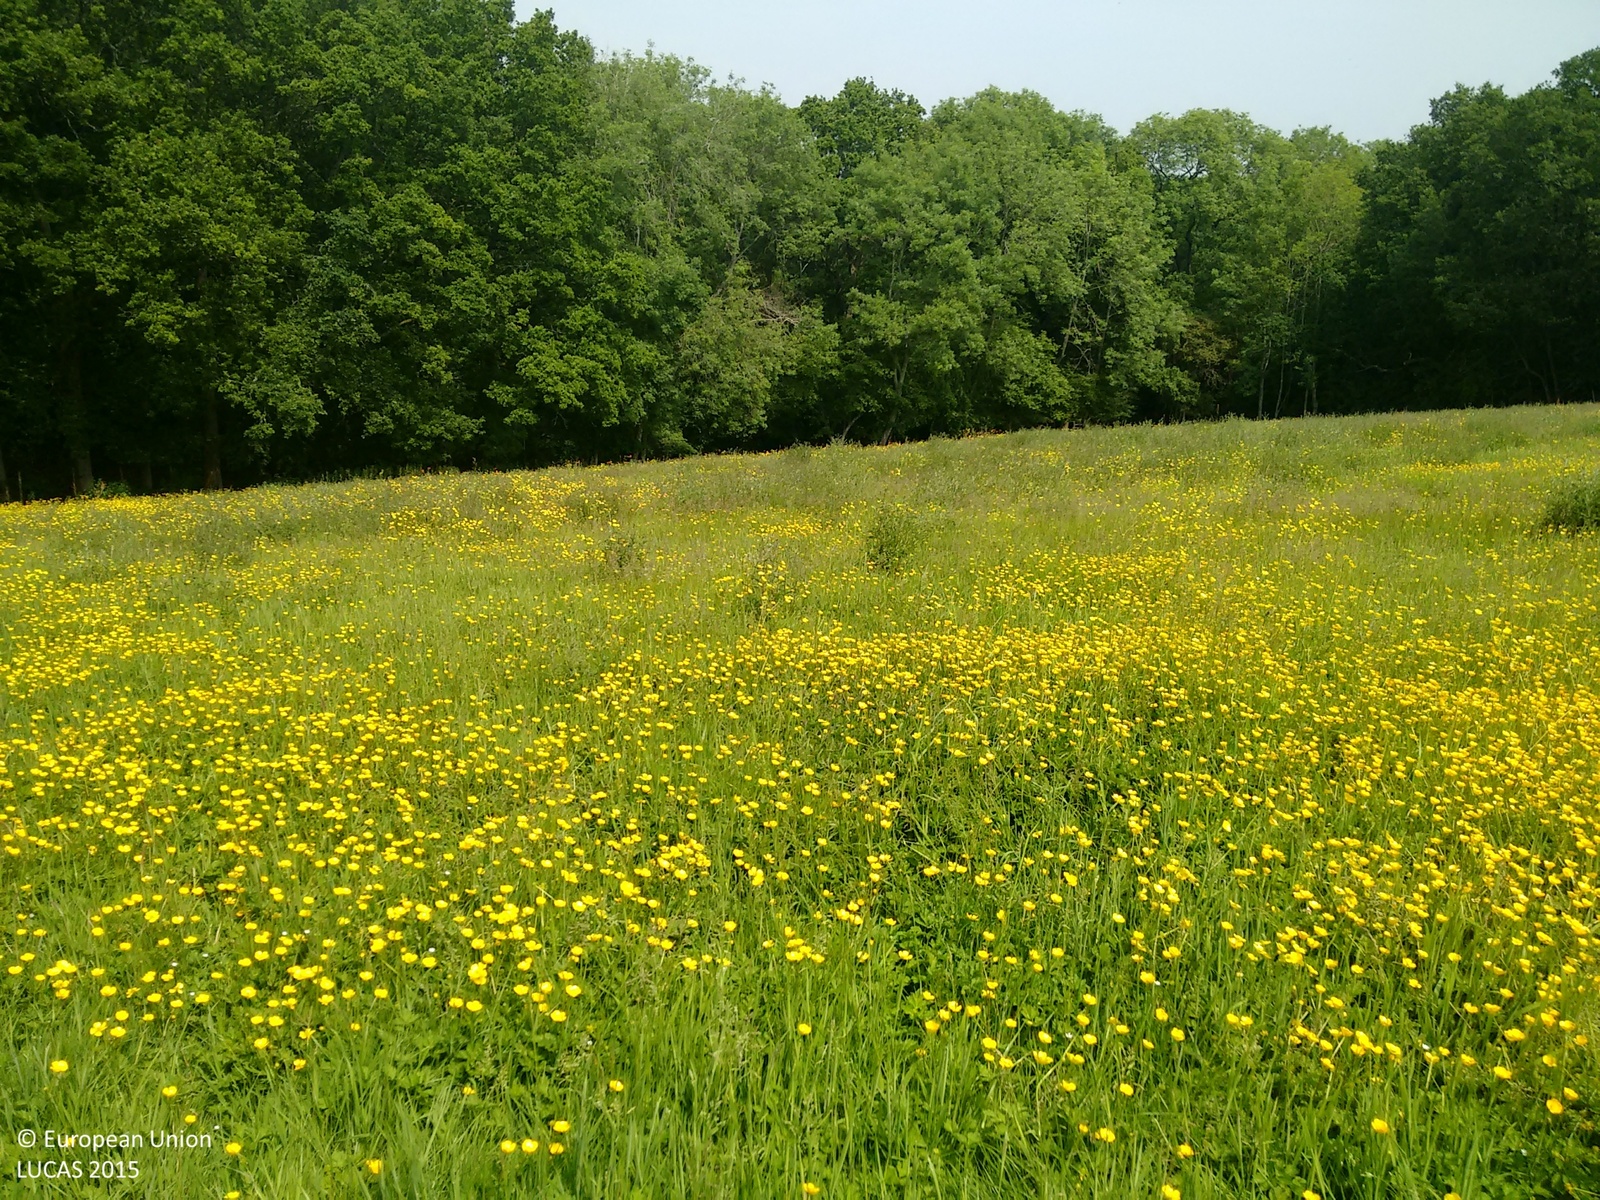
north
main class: Grassland
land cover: Grassland without tree/shrub cover
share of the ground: > 75 %
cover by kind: herbaceous plants 100 %
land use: Agriculture (excluding fallow land and kitchen gardens)
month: June
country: GB
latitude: 51.0365
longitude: 0.2869
